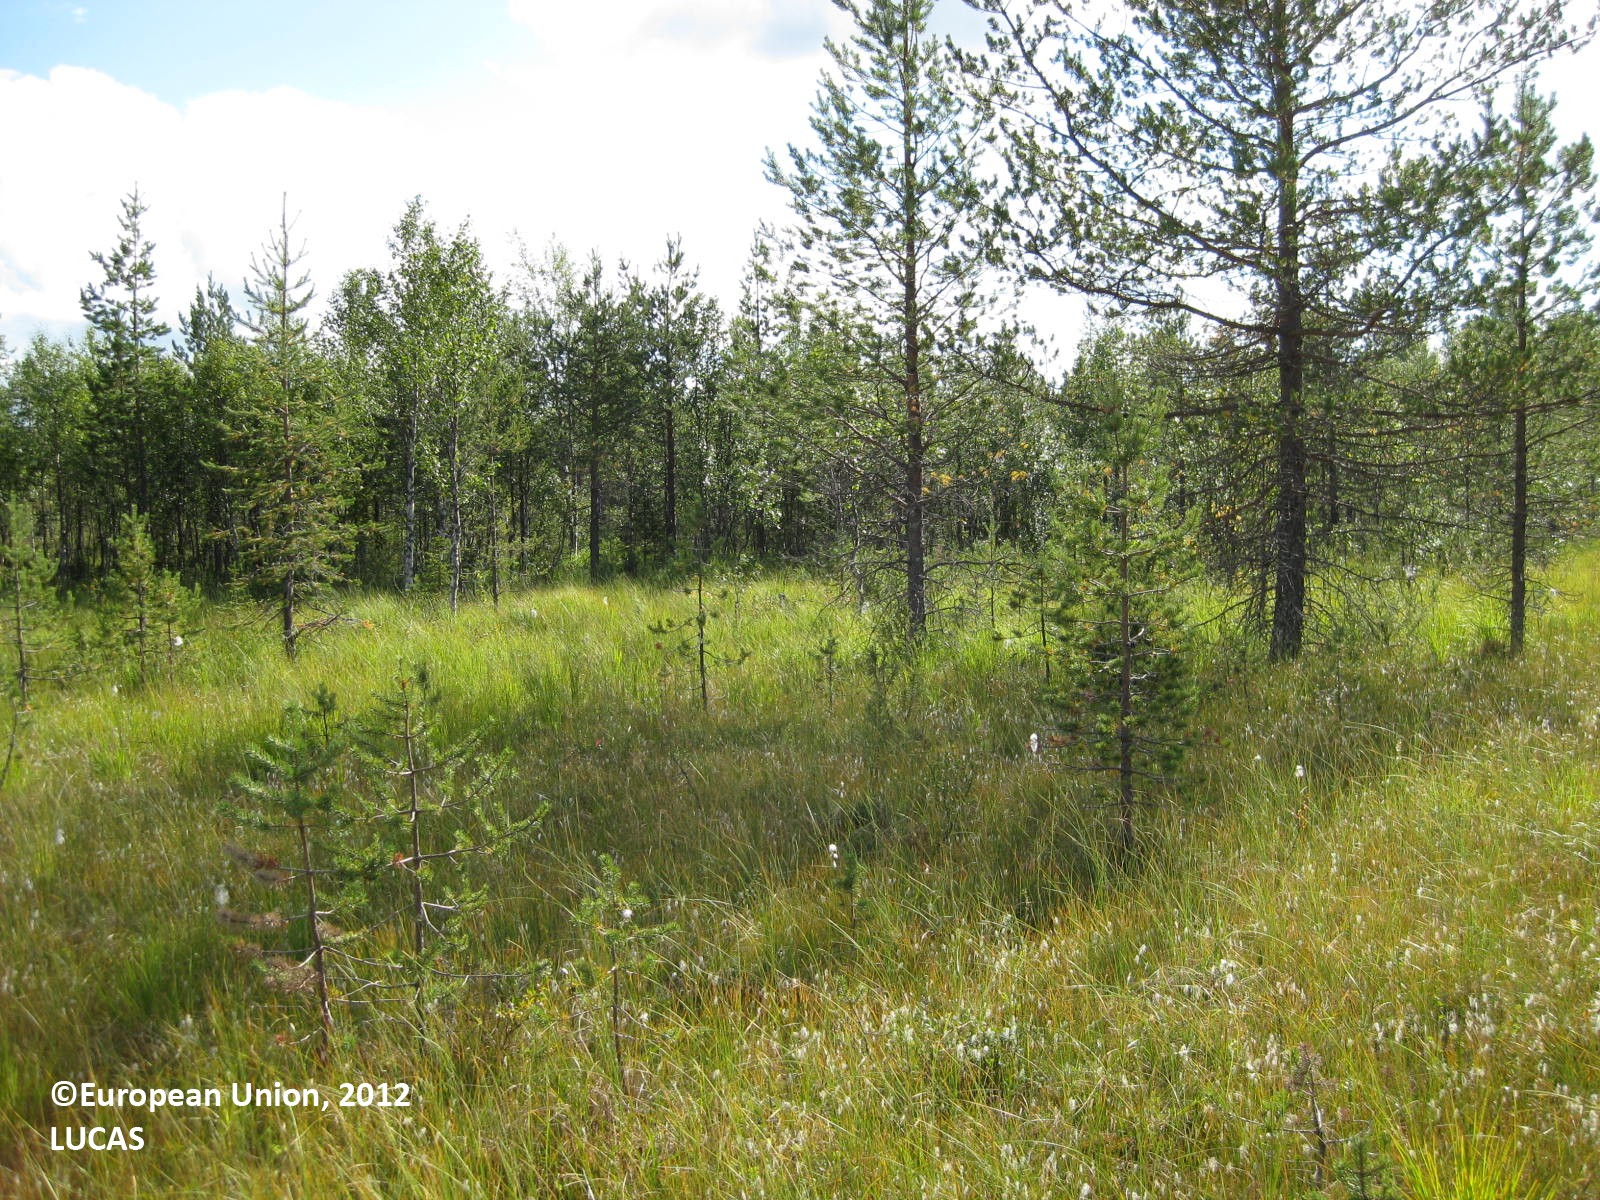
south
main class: Woodland
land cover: Pine dominated coniferous woodland
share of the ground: 25 - 50 %
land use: Semi-natural and natural areas not in use
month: August
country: FI
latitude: 66.4124
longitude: 29.0458
